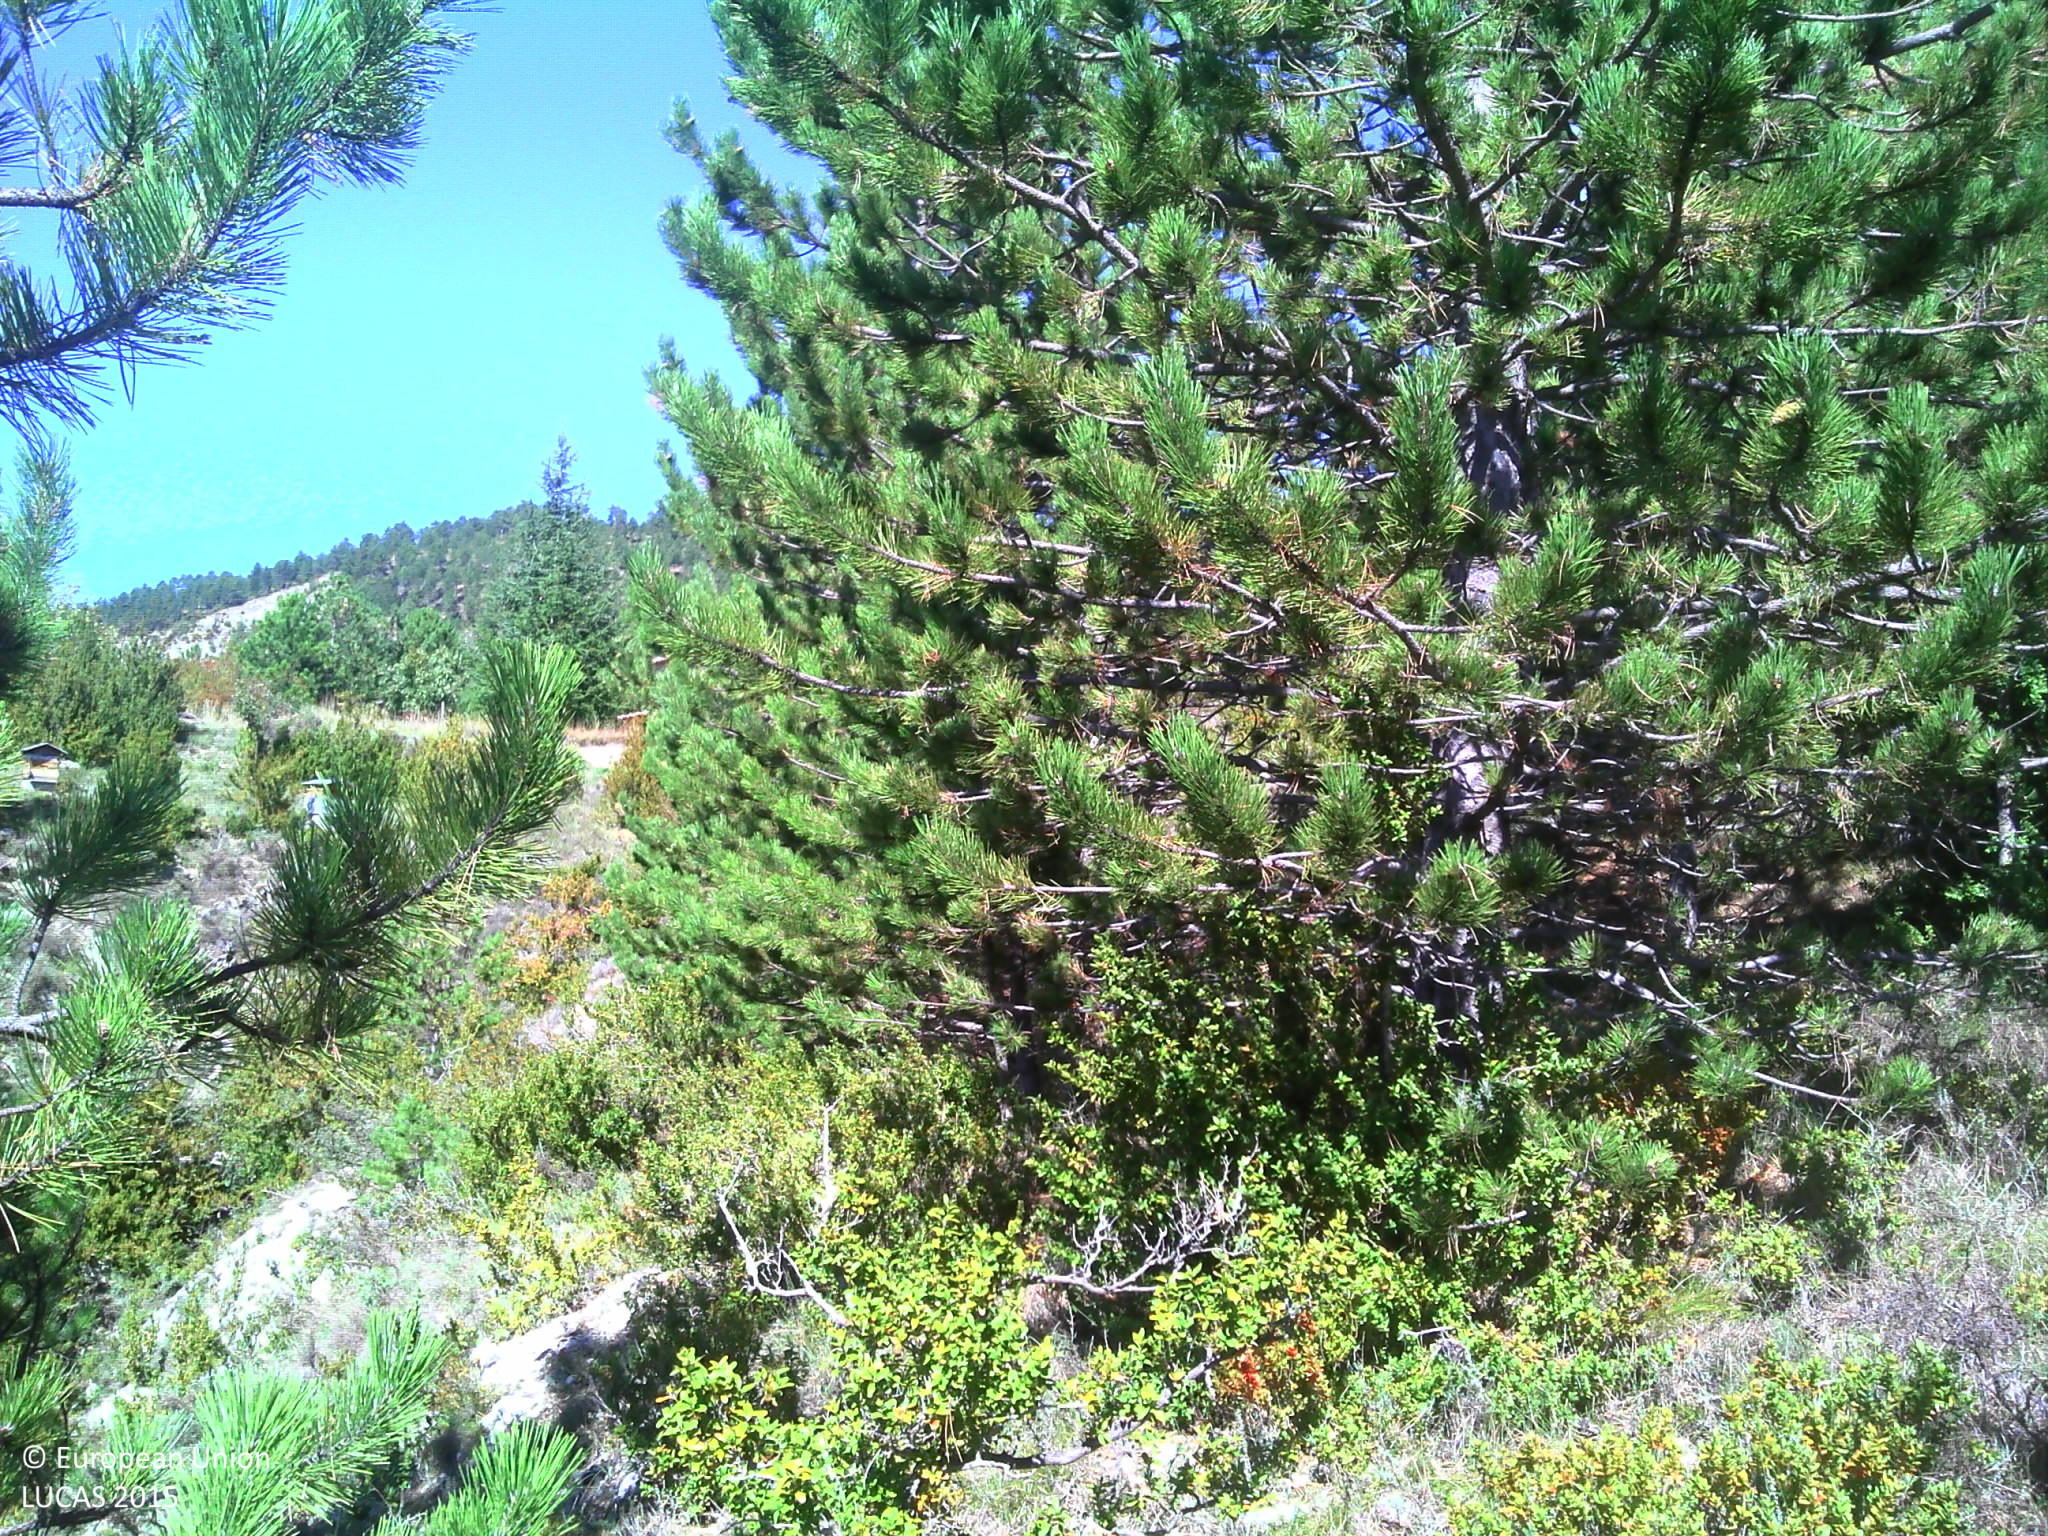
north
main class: Woodland
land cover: Pine dominated coniferous woodland
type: coniferous forest of the mediterranean region
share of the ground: > 75 %
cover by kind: coniferous forest trees 95 %, broadleaved forest trees 5 %
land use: Forestry
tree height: > 5 m
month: September
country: FR
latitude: 44.3875
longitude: 5.2749
